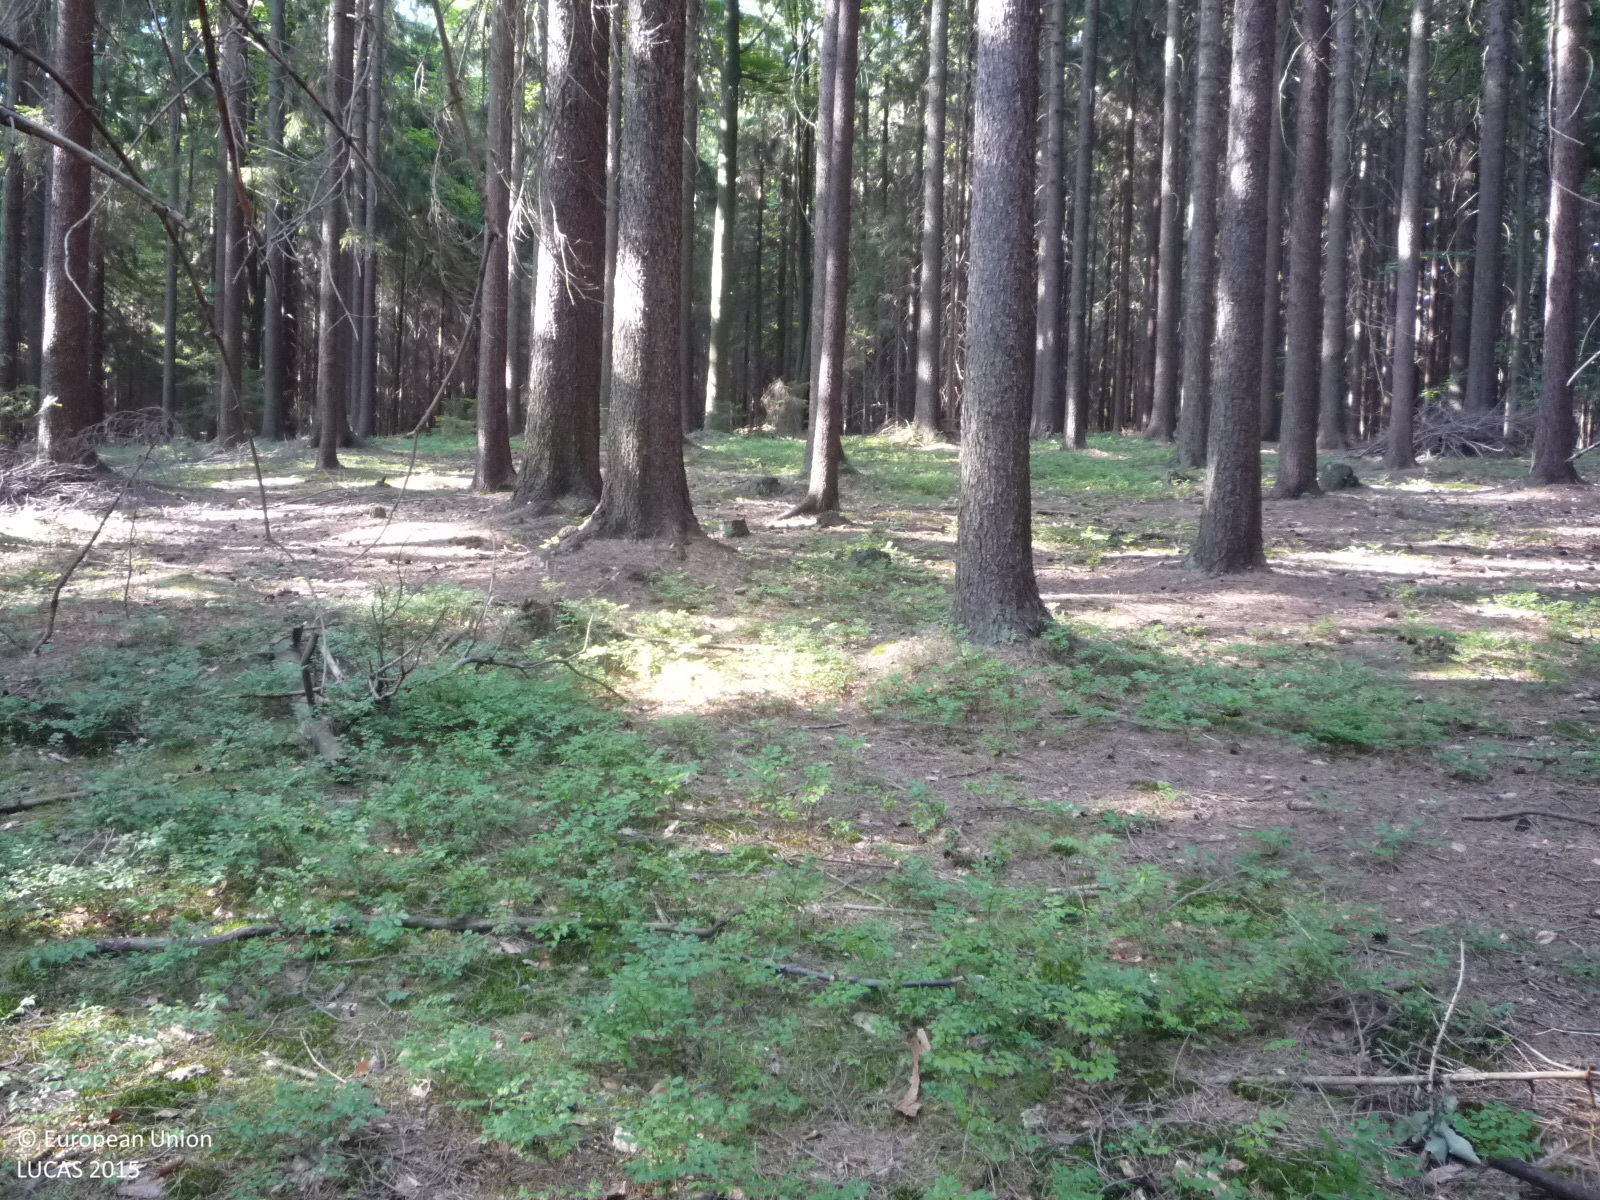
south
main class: Woodland
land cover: Spruce dominated coniferous woodland
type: hemiboreal forest and nemoral coniferous forest and mixed broadleaved-coniferous forest
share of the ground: > 75 %
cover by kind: coniferous forest trees 90 %, shrubs 5 %, unconsolidated bare surface 5 %
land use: Forestry
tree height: > 5 m
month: August
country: CZ
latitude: 50.6938
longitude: 15.2556
